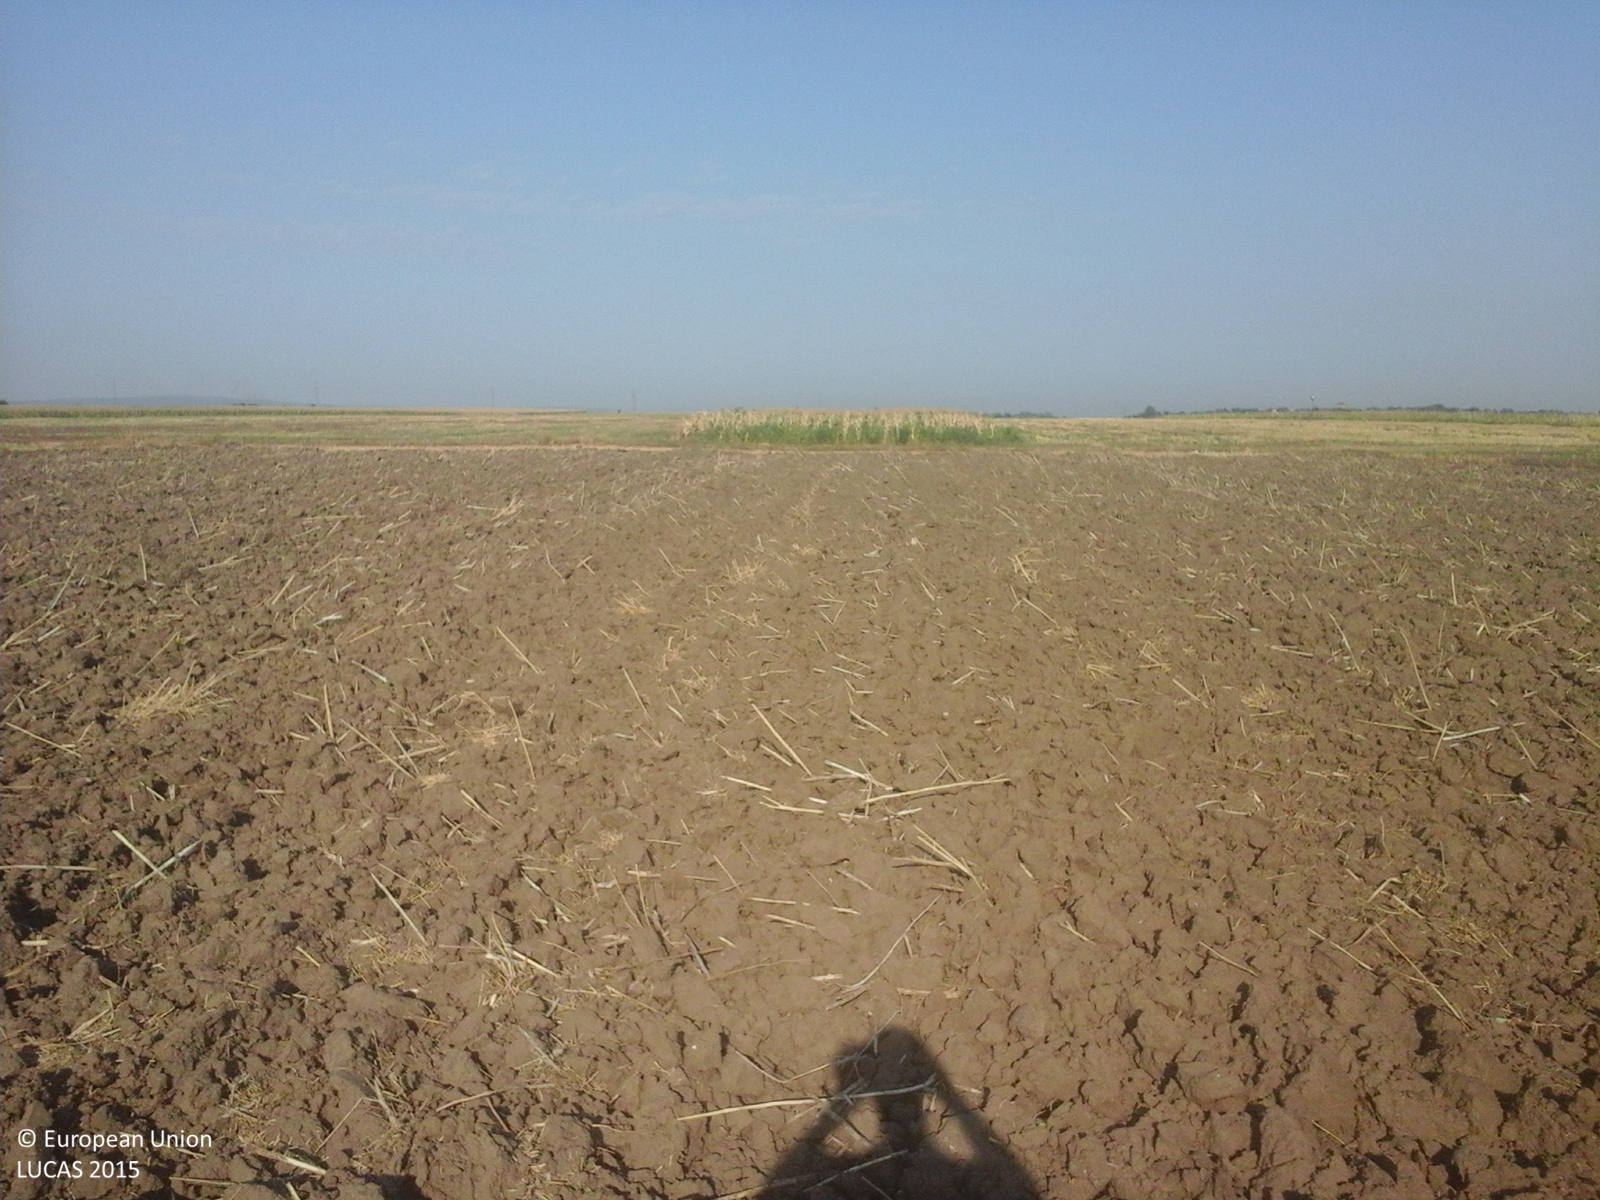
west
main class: Cropland
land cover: Rape and turnip rape
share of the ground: < 10 %
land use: Agriculture (excluding fallow land and kitchen gardens)
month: August
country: RO
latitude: 44.1661
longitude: 23.0115
